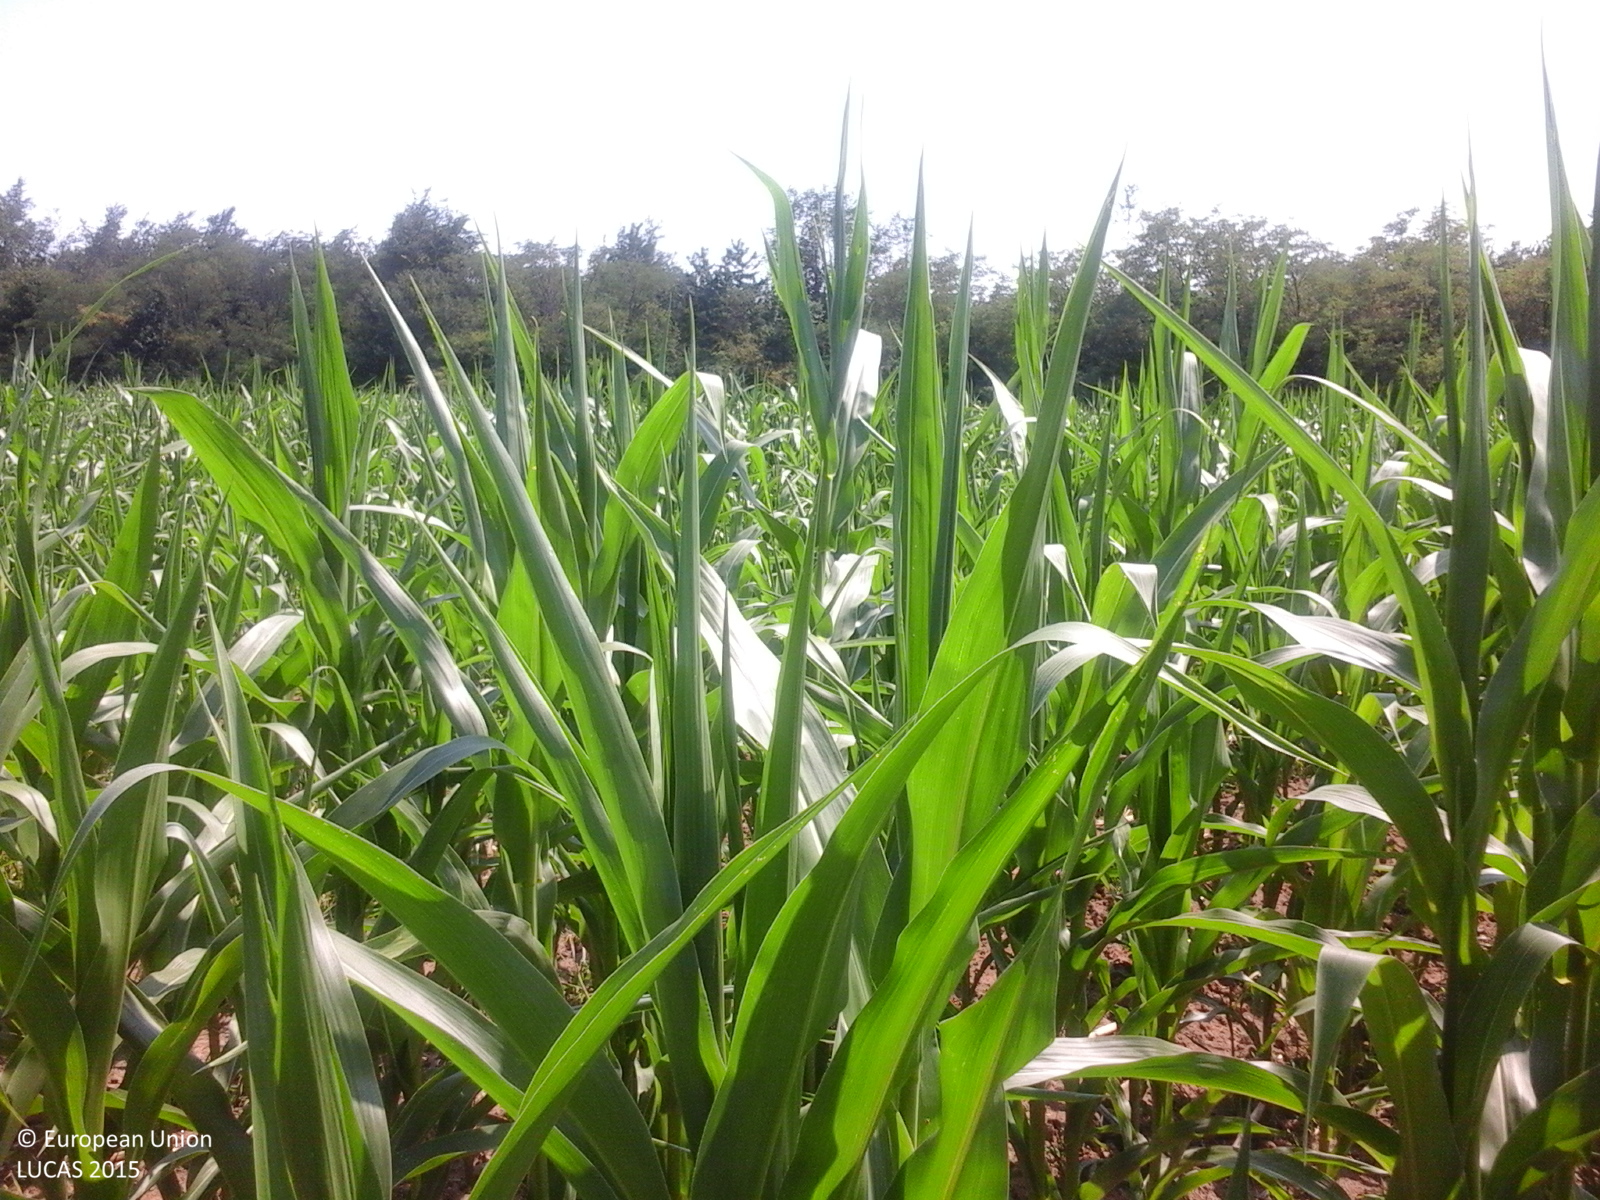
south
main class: Cropland
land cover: Maize
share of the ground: > 75 %
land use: Agriculture (excluding fallow land and kitchen gardens)
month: July
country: RO
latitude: 44.7199
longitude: 24.7347
